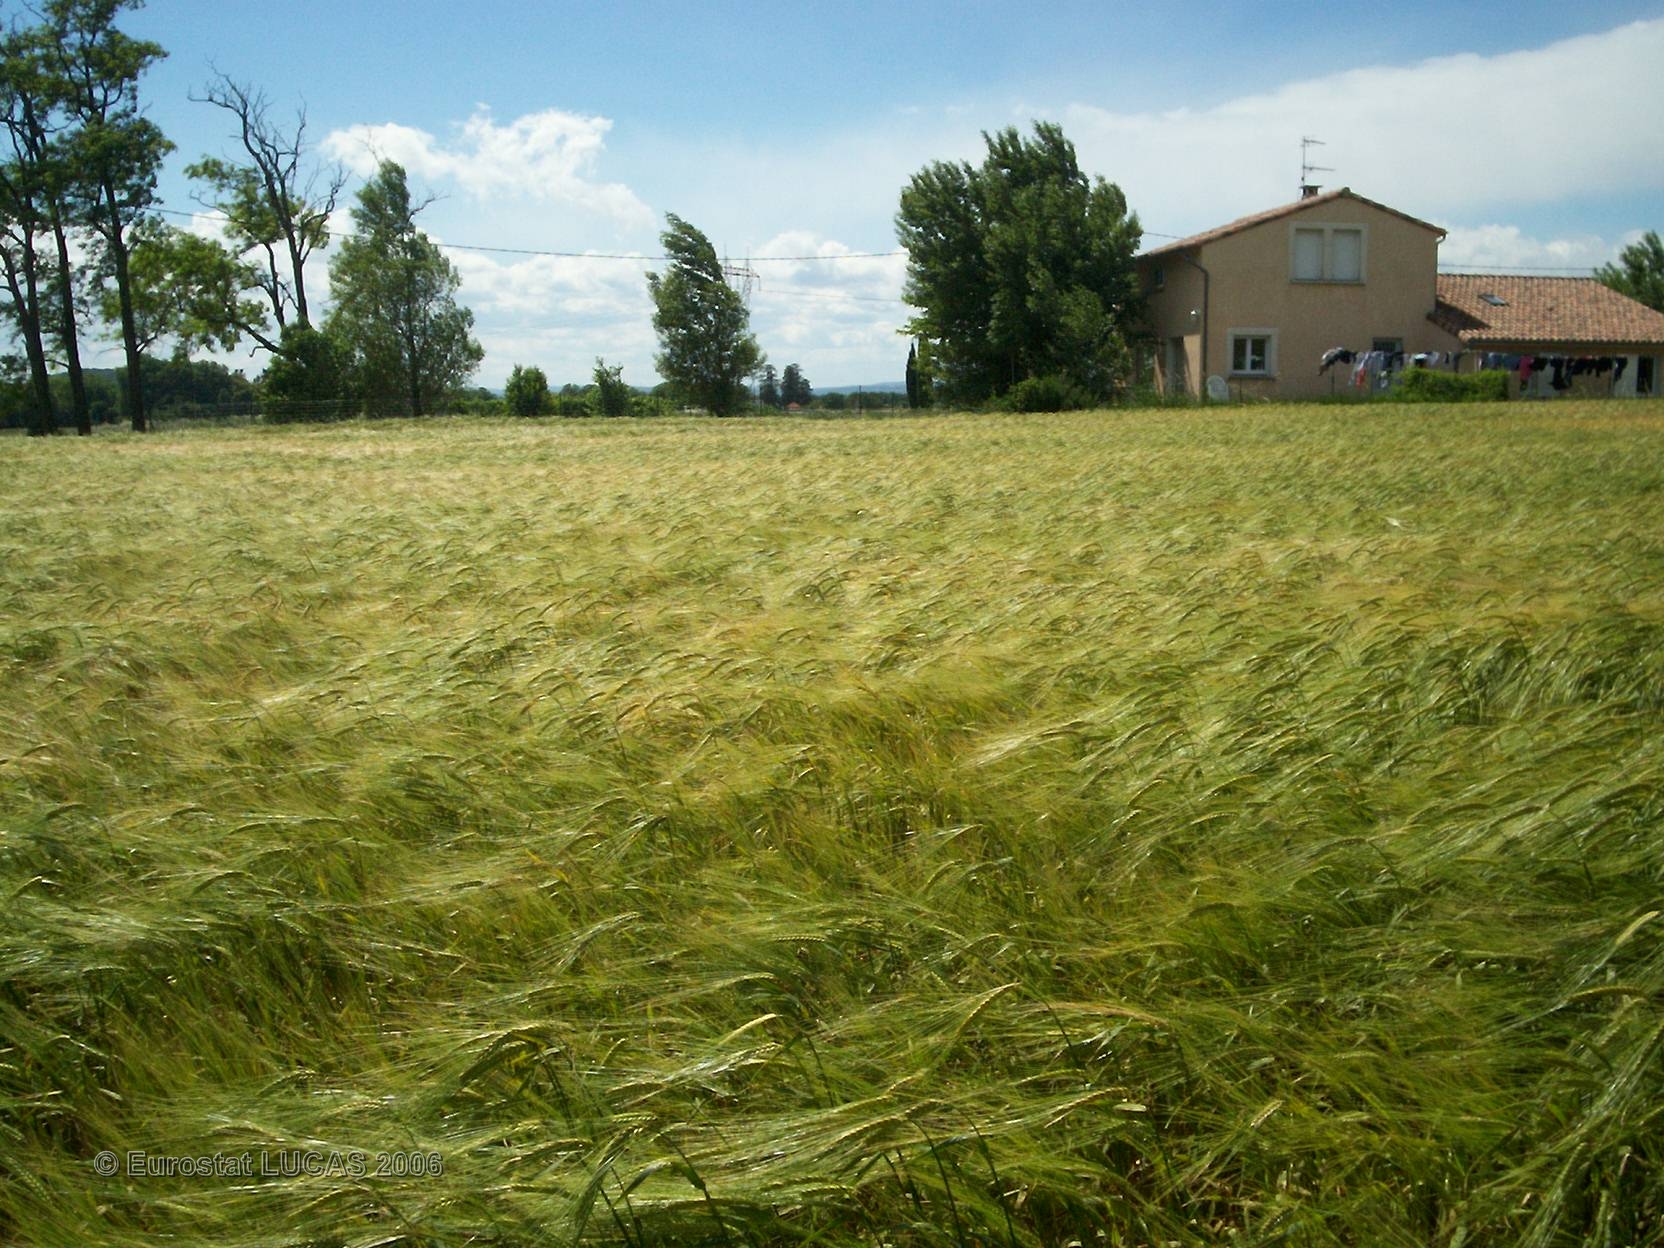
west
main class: Cropland
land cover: Barley
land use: Agriculture (excluding fallow land and kitchen gardens)
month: May
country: FR
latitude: 44.5471
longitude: 4.8335
